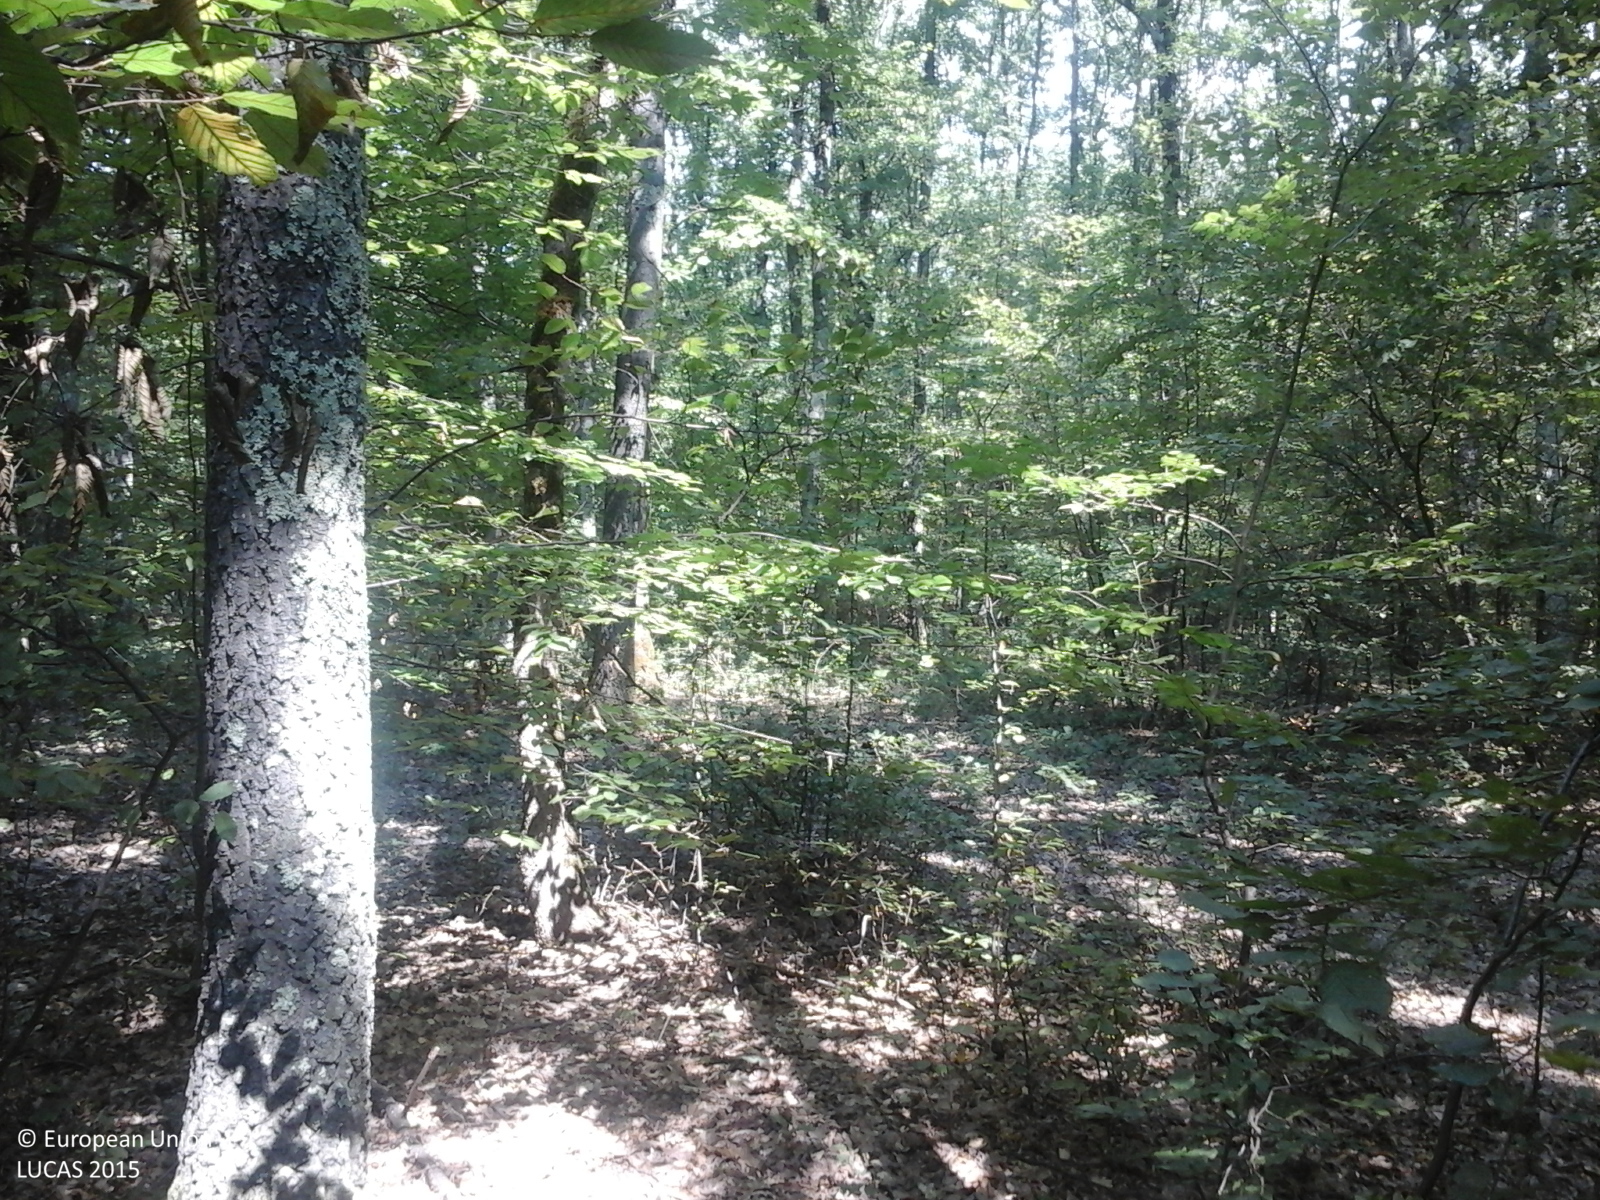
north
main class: Woodland
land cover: Broadleaved woodland
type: beech forest
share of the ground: > 75 %
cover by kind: broadleaved forest trees 100 %
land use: Forestry
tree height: > 5 m
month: August
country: RO
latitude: 46.3715
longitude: 21.9375
